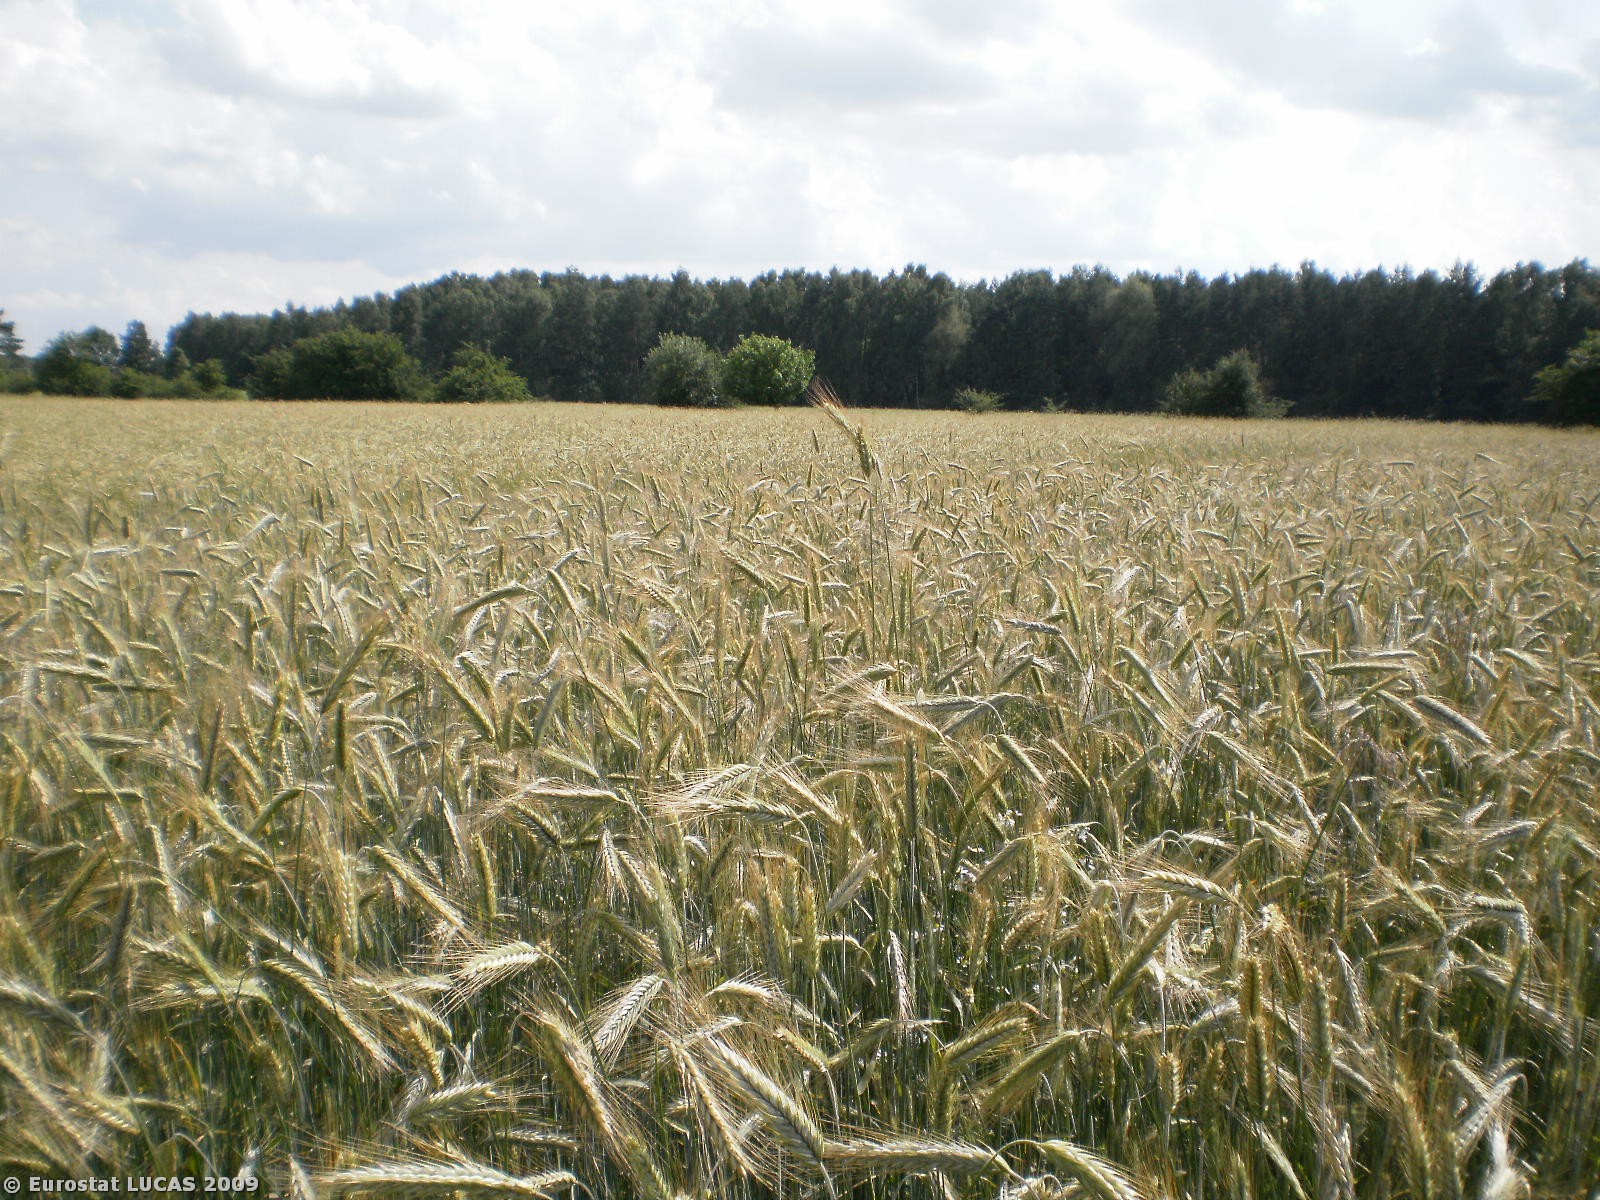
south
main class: Cropland
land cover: Triticale
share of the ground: > 75 %
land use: Agriculture (excluding fallow land and kitchen gardens)
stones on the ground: 10 - 25 %
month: July
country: PL
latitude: 53.2945
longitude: 20.4337
